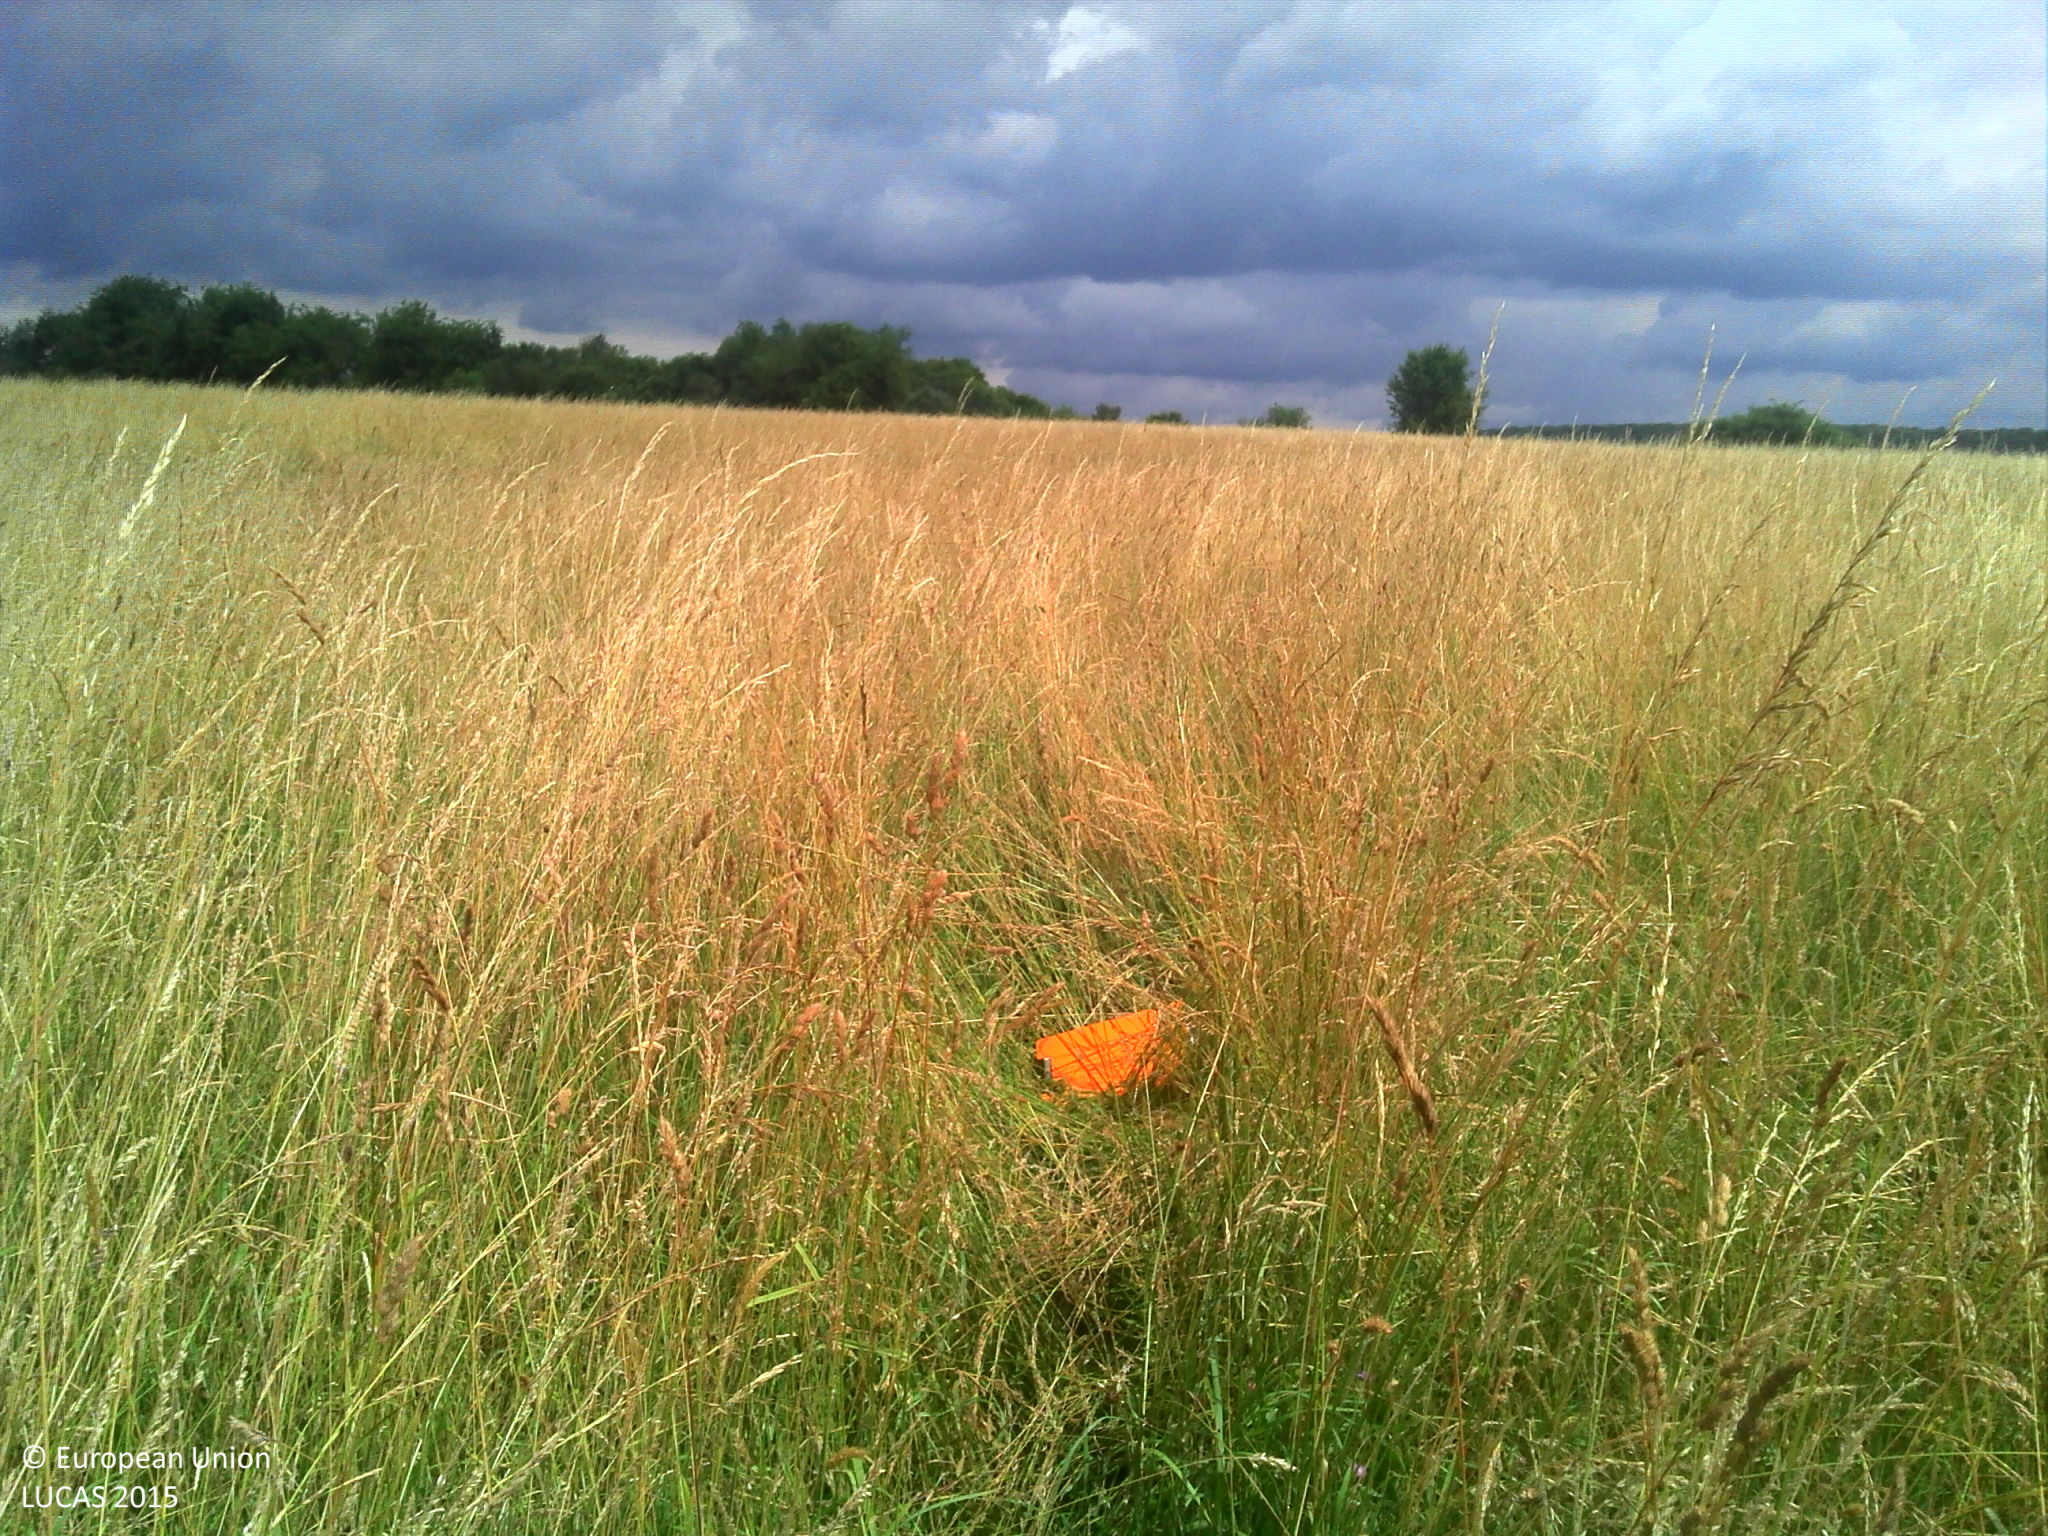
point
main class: Cropland
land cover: Temporary grasslands
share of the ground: > 75 %
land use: Agriculture (excluding fallow land and kitchen gardens)
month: June
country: FR
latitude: 47.6584
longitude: 6.3396
